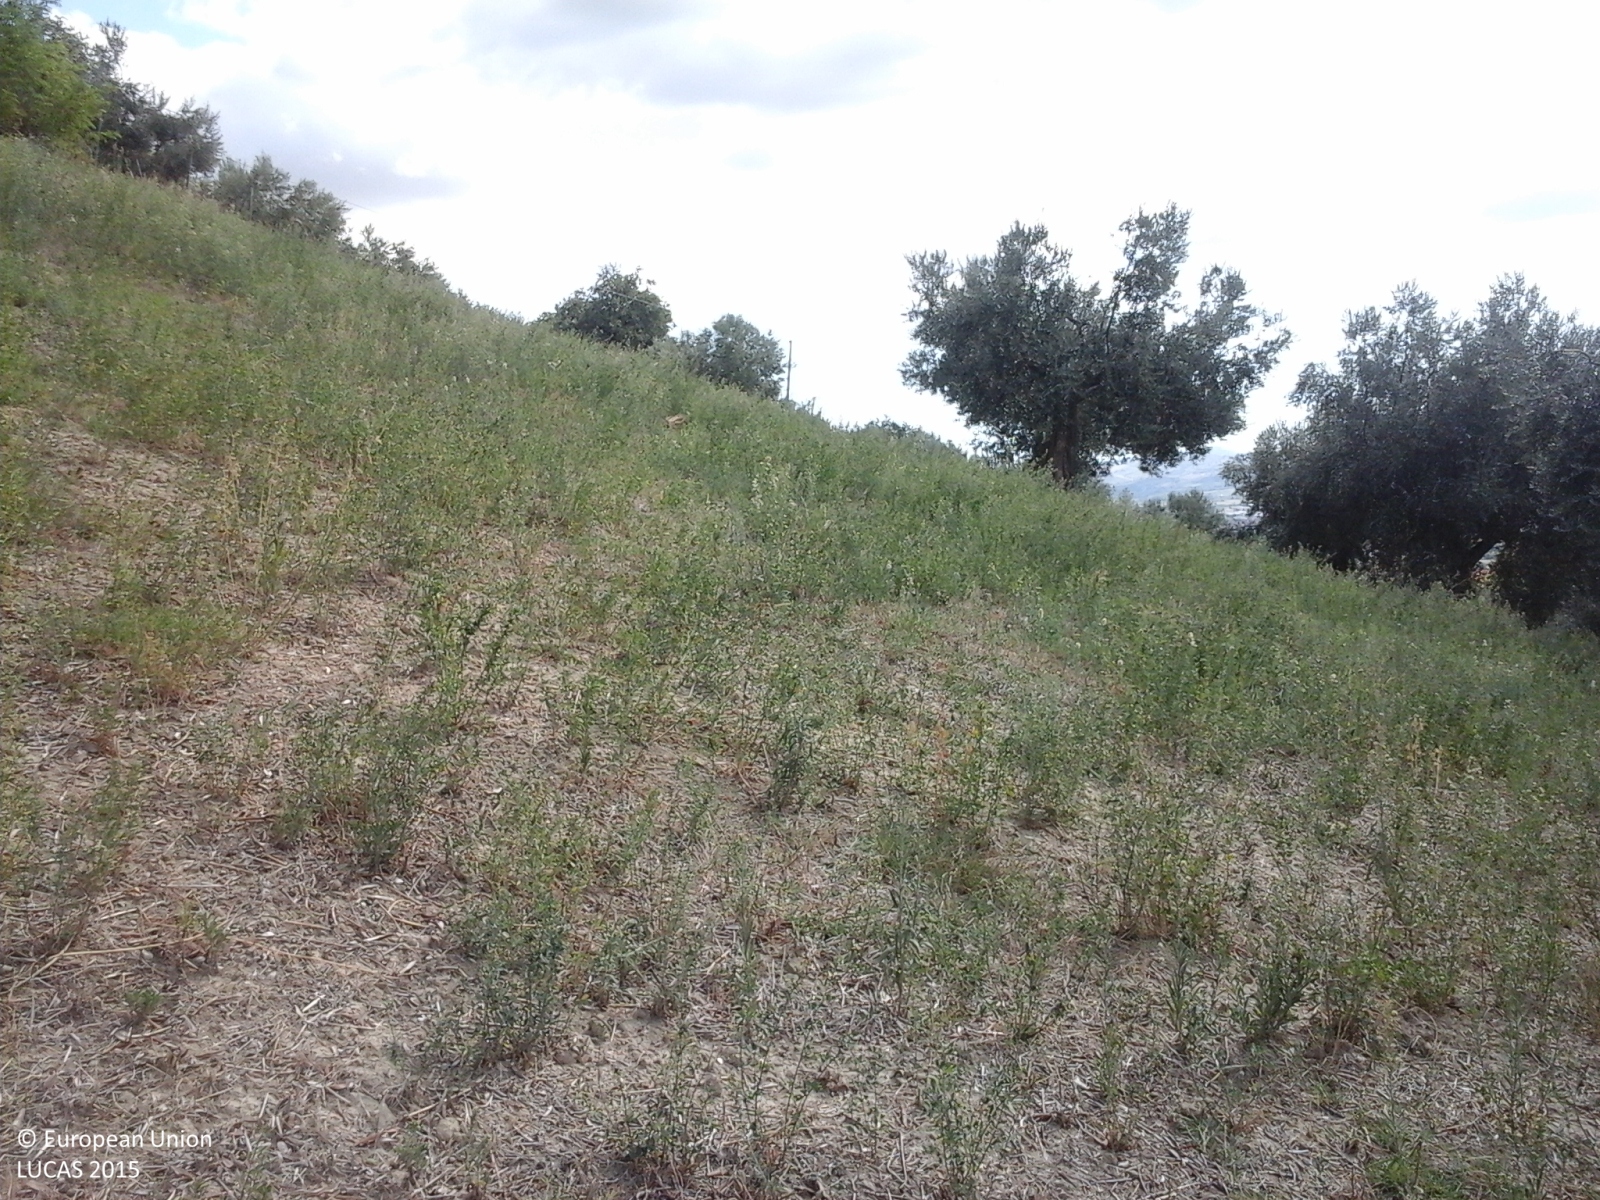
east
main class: Cropland
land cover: Olive groves
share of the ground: 10 - 25 %
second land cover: Tomatoes
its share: 50 - 75 %
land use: Agriculture (excluding fallow land and kitchen gardens)
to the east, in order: Olive groves; Tomatoes; Lucerne; Electric lines; Lucerne; Abandoned hedges; Paved roads, cycling and walking lanes; Abandoned hedges; Lucerne; Olive groves
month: September
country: IT
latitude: 42.6368
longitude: 13.8059
